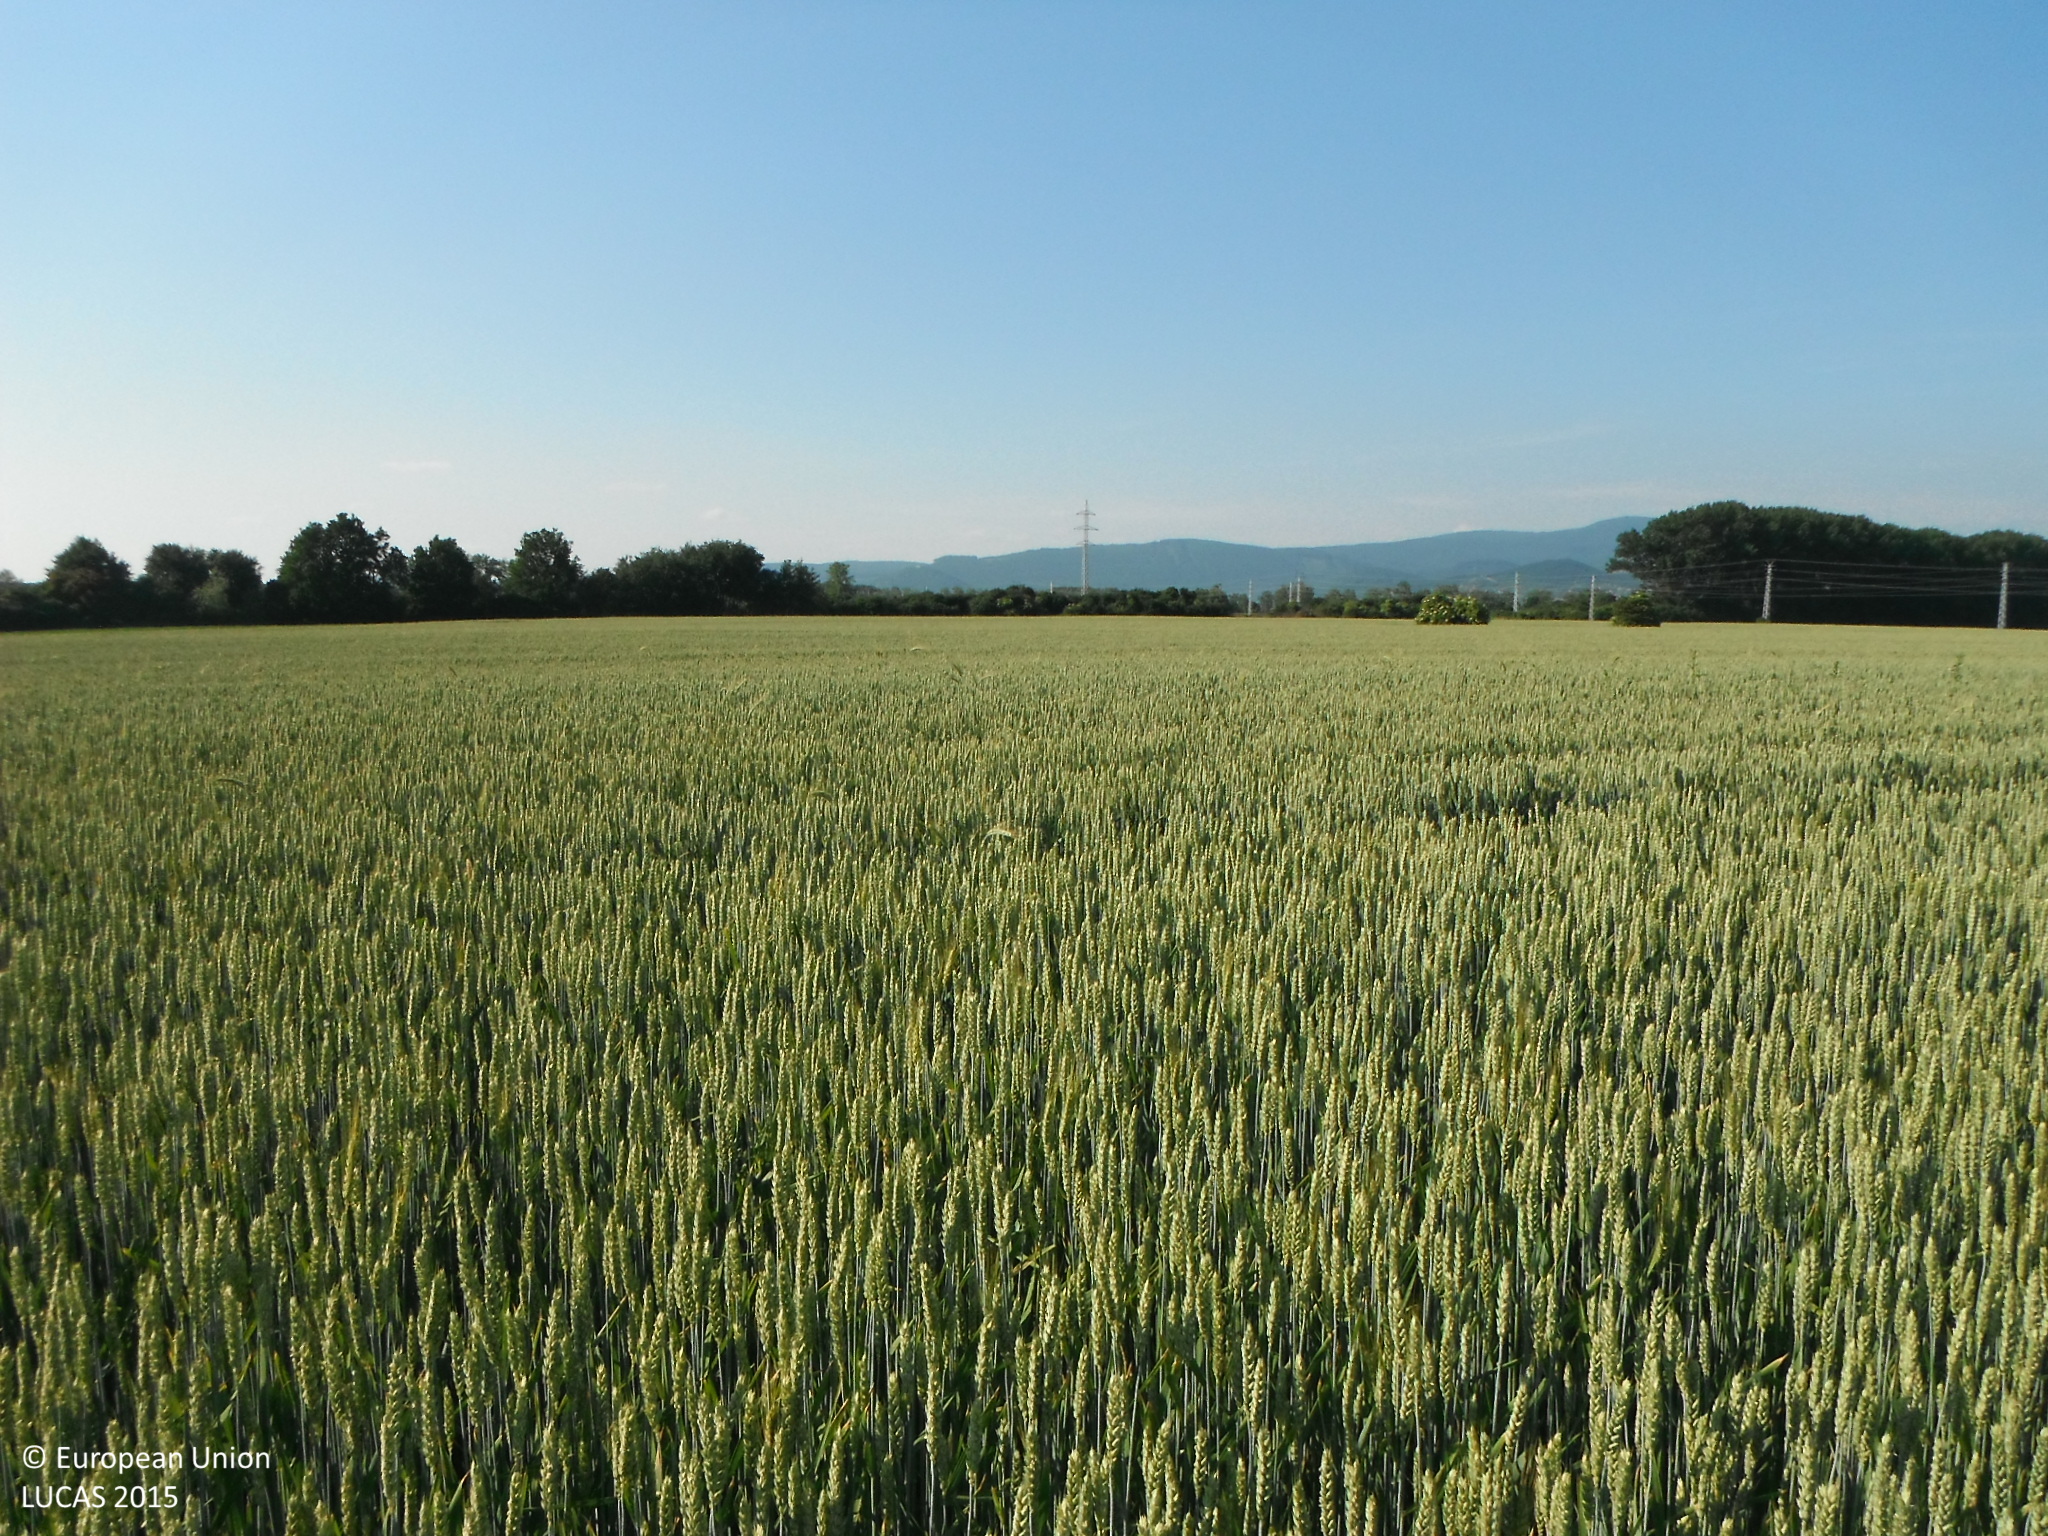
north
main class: Cropland
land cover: Common wheat
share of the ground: > 75 %
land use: Agriculture (excluding fallow land and kitchen gardens)
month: June
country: SK
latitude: 48.7524
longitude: 21.9554
